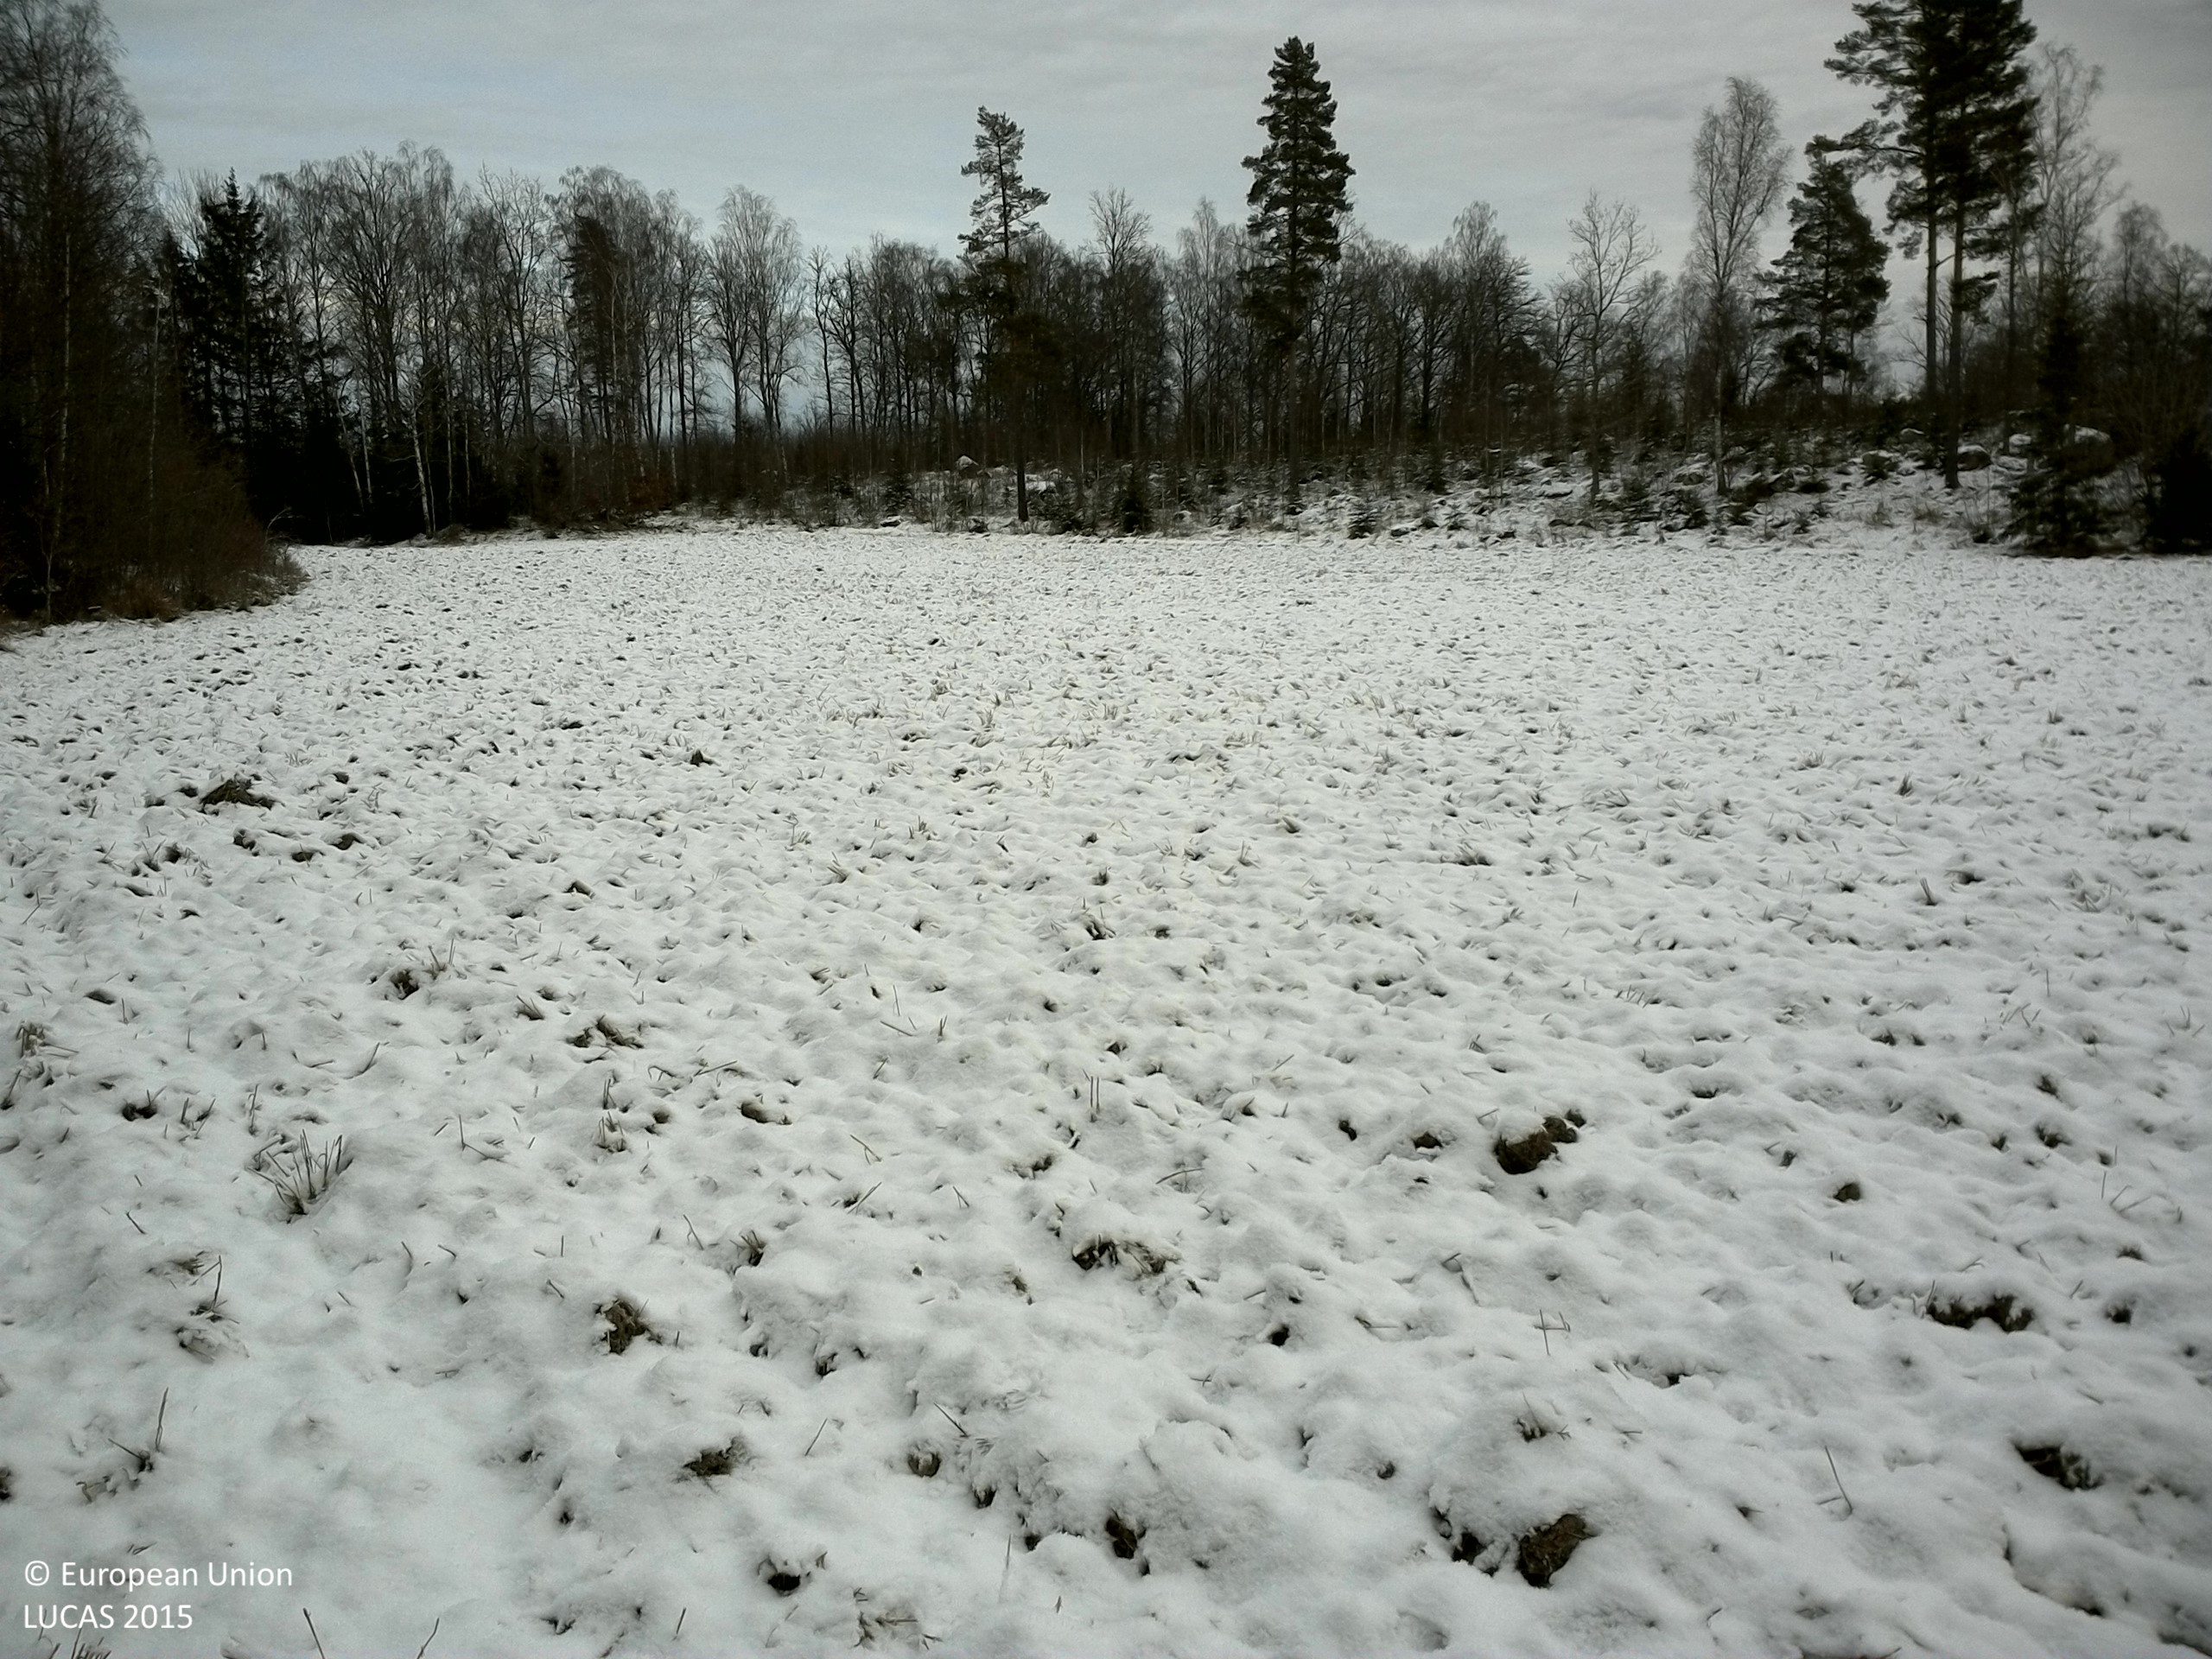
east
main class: Woodland
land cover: Broadleaved woodland
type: boreal forest
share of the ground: 50 - 75 %
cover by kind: broadleaved forest trees 50 %, herbaceous plants 20 %, coniferous forest trees 15 %, lichens and mosses 10 %, shrubs 5 %
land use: Forestry
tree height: > 5 m
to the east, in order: Temporary grasslands; Other bare soil; Grass margins; Ditches and canals; Spruce dominated mixed woodland; Tracks; Spruce dominated mixed woodland; Tracks; Broadleaved woodland; Electric lines; Spontaneously vegetated surfaces; Other bare soil
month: December
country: SE
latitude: 59.5161
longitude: 16.3012
